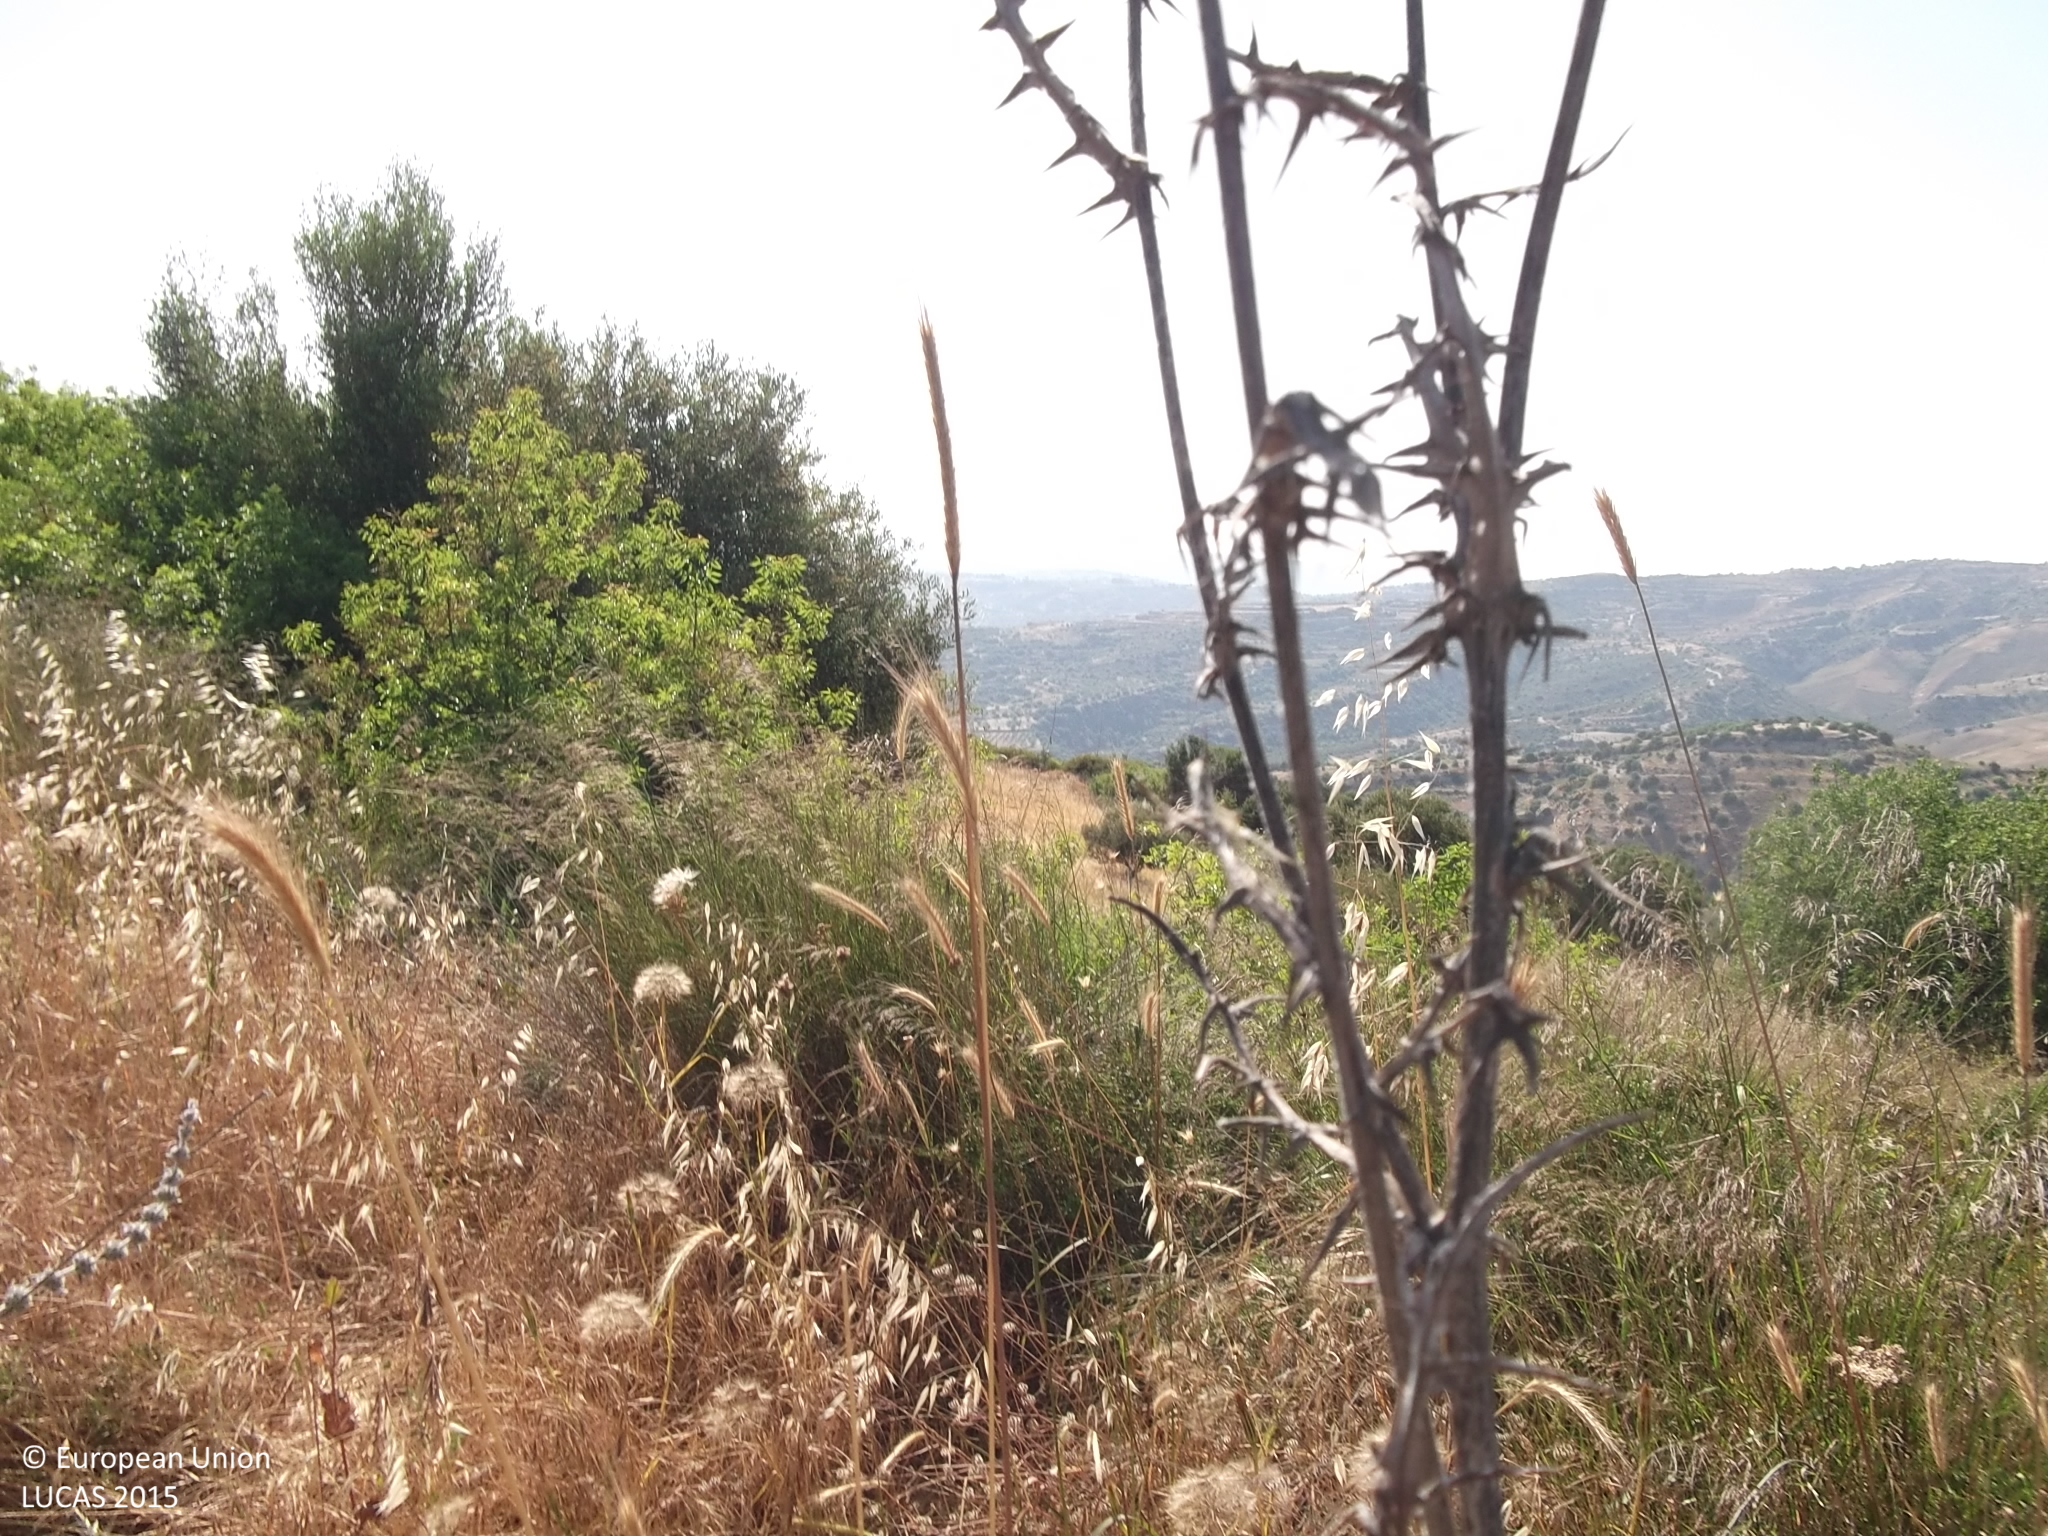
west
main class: Grassland
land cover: Grassland with sparse tree/shrub cover
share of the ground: > 75 %
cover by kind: herbaceous plants 90 %, broadleaved forest trees 5 %, shrubs 5 %
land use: Semi-natural and natural areas not in use
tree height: < 5 m
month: May
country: CY
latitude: 34.8835
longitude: 32.5724
